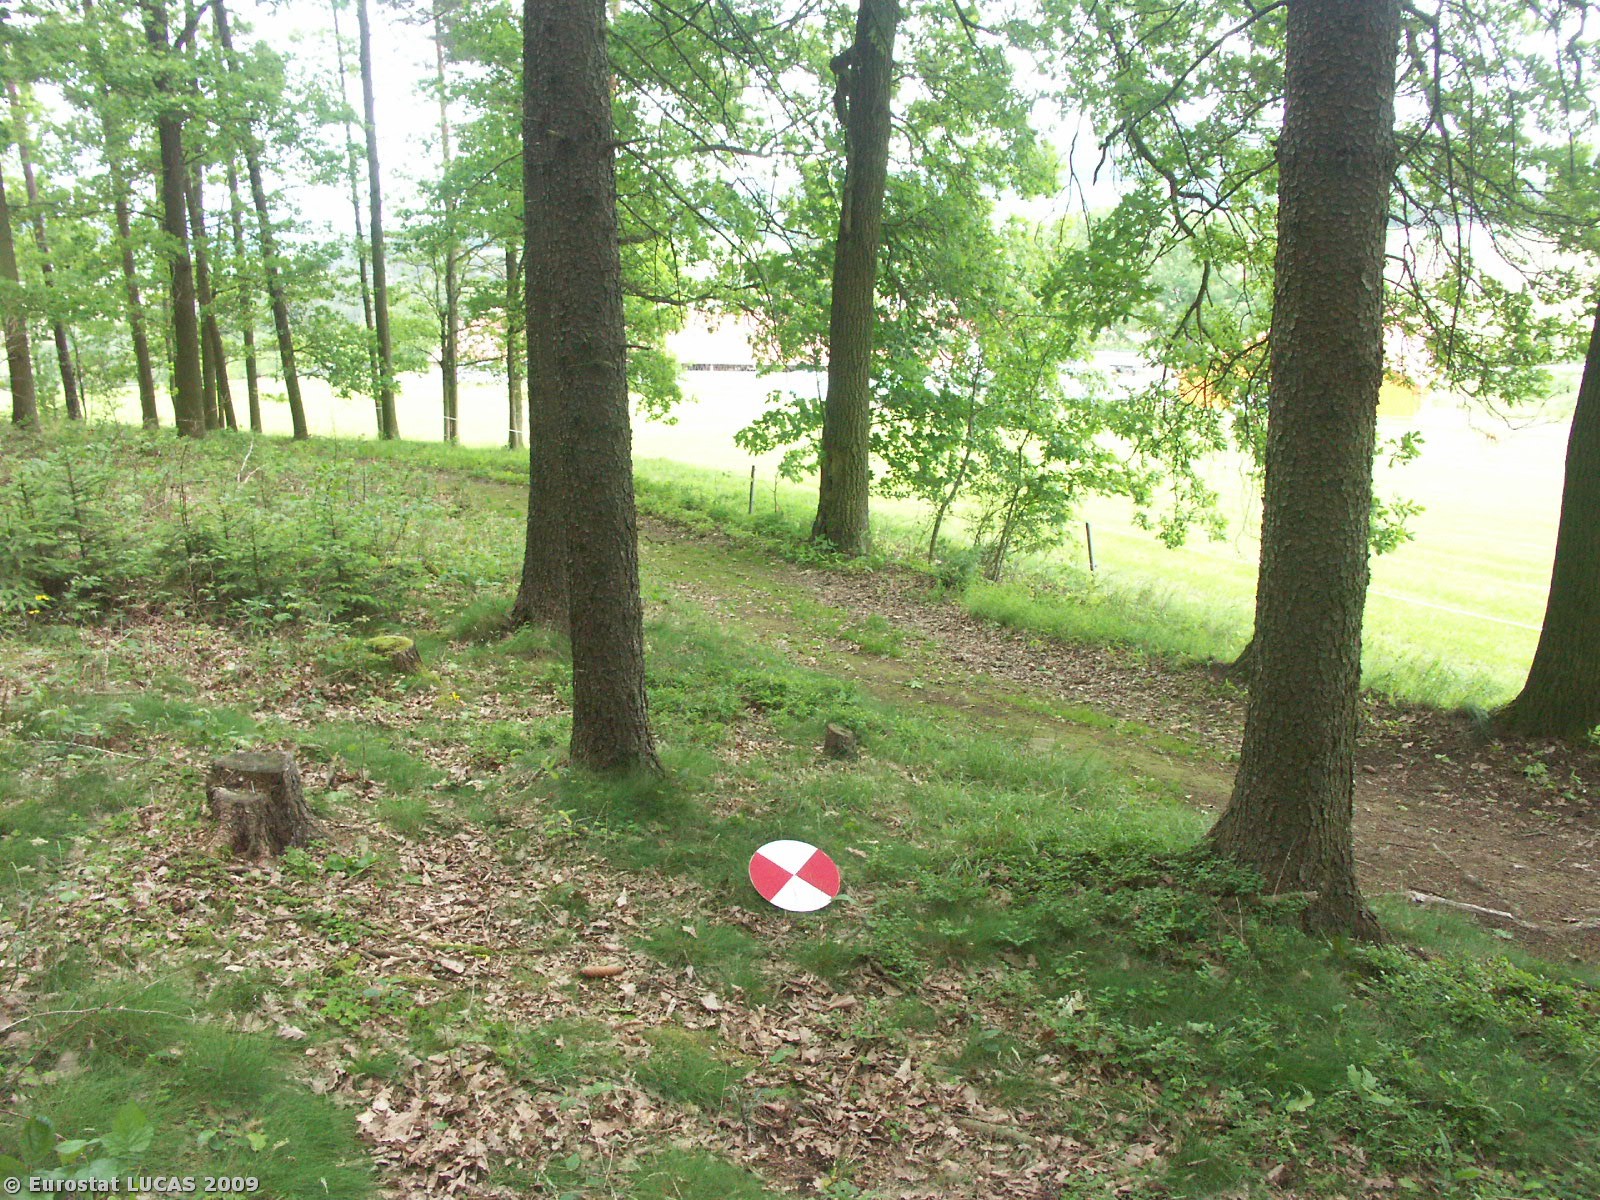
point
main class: Woodland
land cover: Mixed woodland
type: hemiboreal forest and nemoral coniferous forest and mixed broadleaved-coniferous forest
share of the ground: > 75 %
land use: Forestry
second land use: Nature reserves
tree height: > 5 m
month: May
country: CZ
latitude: 48.9145
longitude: 14.2991
